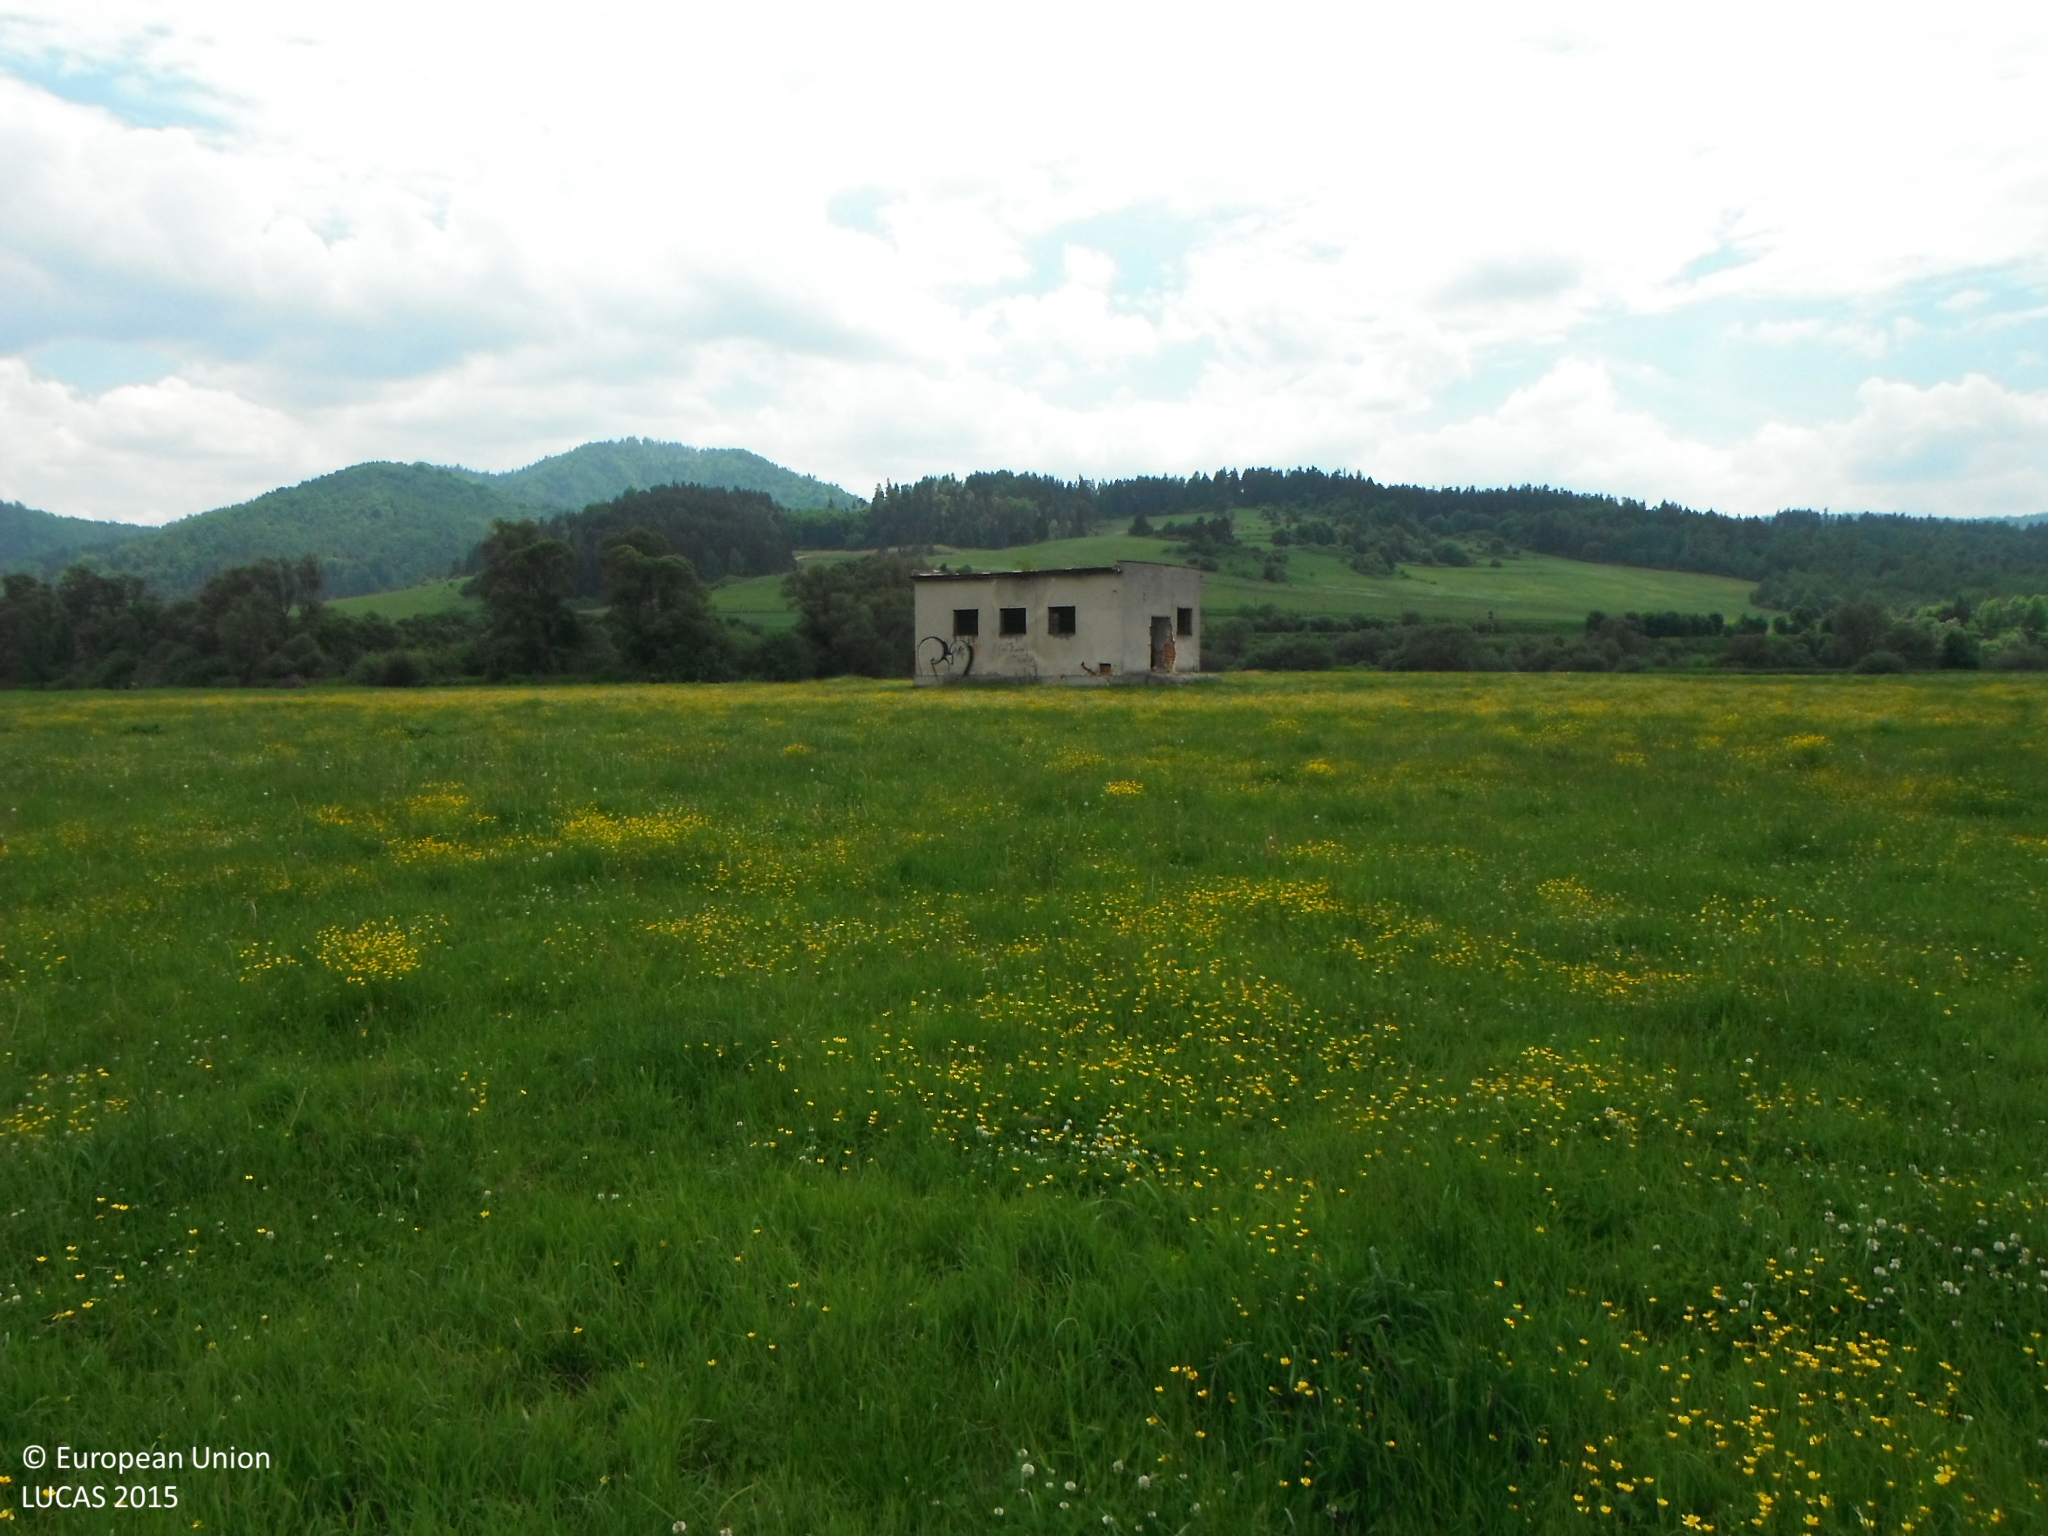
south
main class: Grassland
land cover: Grassland without tree/shrub cover
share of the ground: > 75 %
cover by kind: herbaceous plants 100 %
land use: Agriculture (excluding fallow land and kitchen gardens)
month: June
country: SK
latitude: 48.9426
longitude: 20.8118
